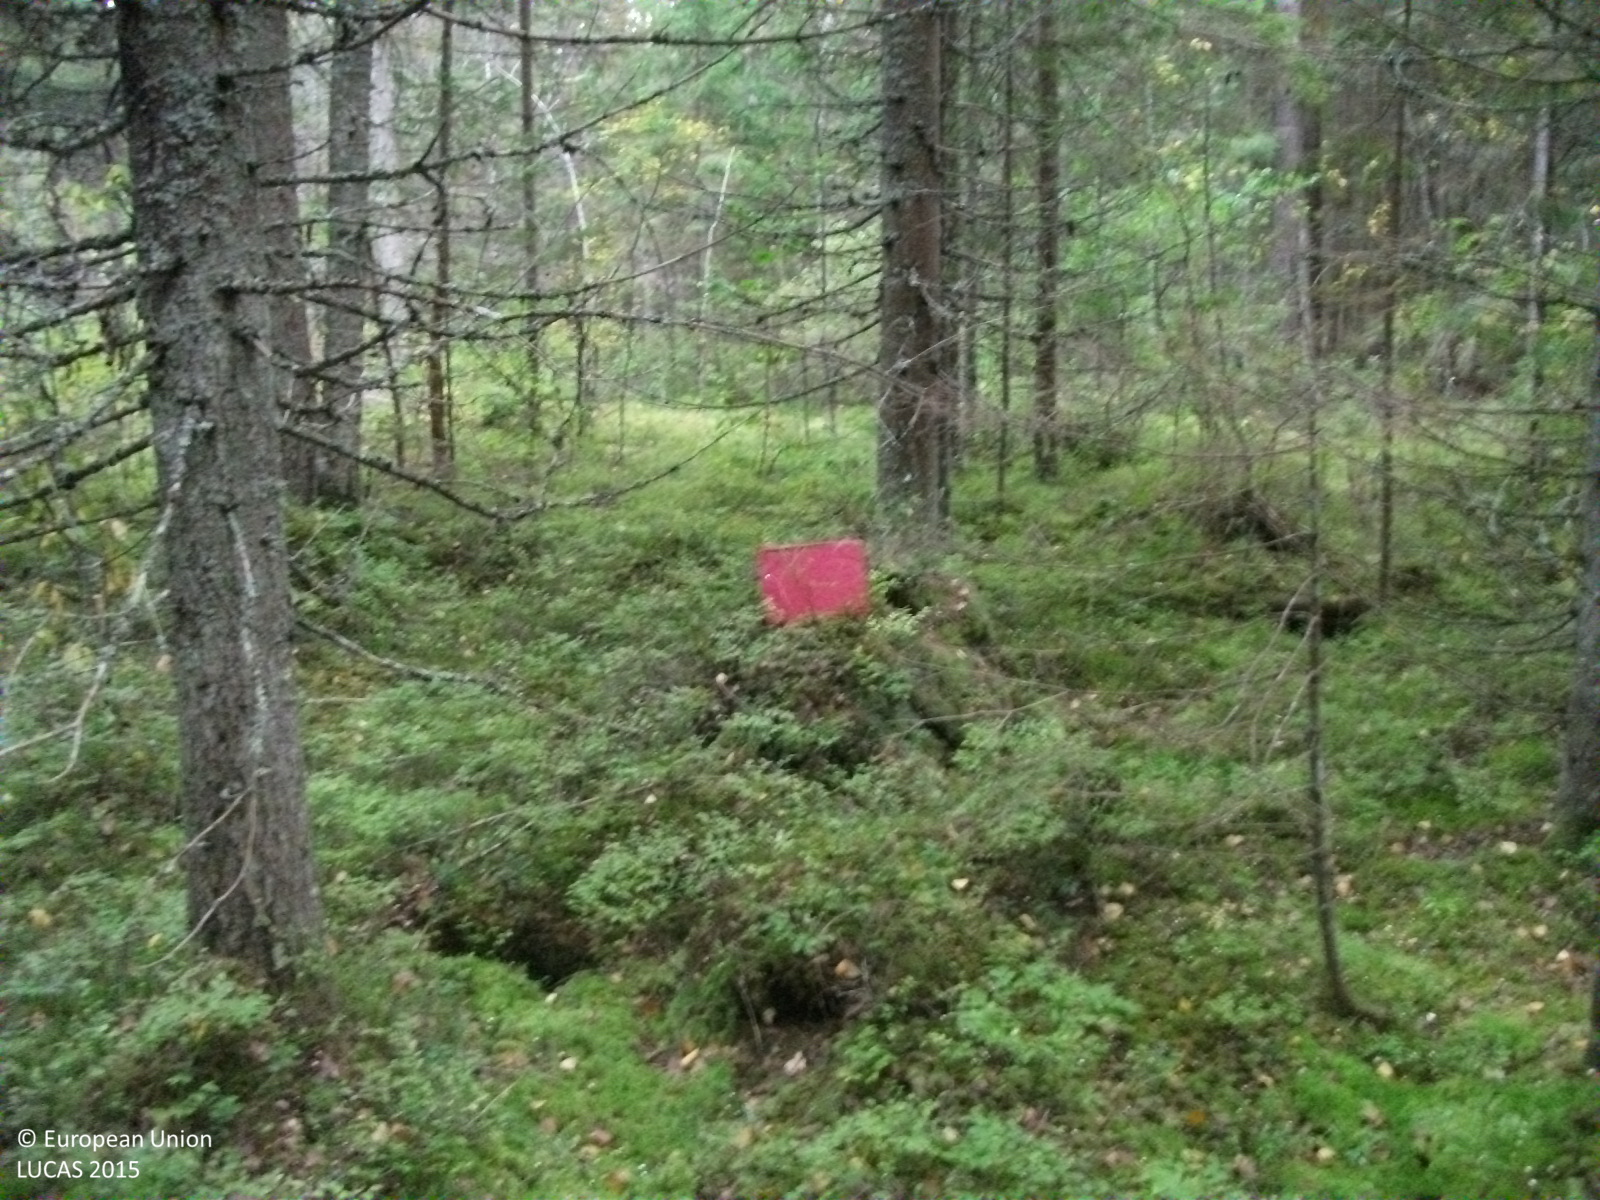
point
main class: Woodland
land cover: Spruce dominated coniferous woodland
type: hemiboreal forest and nemoral coniferous forest and mixed broadleaved-coniferous forest
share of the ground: > 75 %
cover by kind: coniferous forest trees 90 %, shrubs 5 %, lichens and mosses 5 %
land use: Forestry
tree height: > 5 m
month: September
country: LV
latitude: 57.9333
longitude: 24.5629
